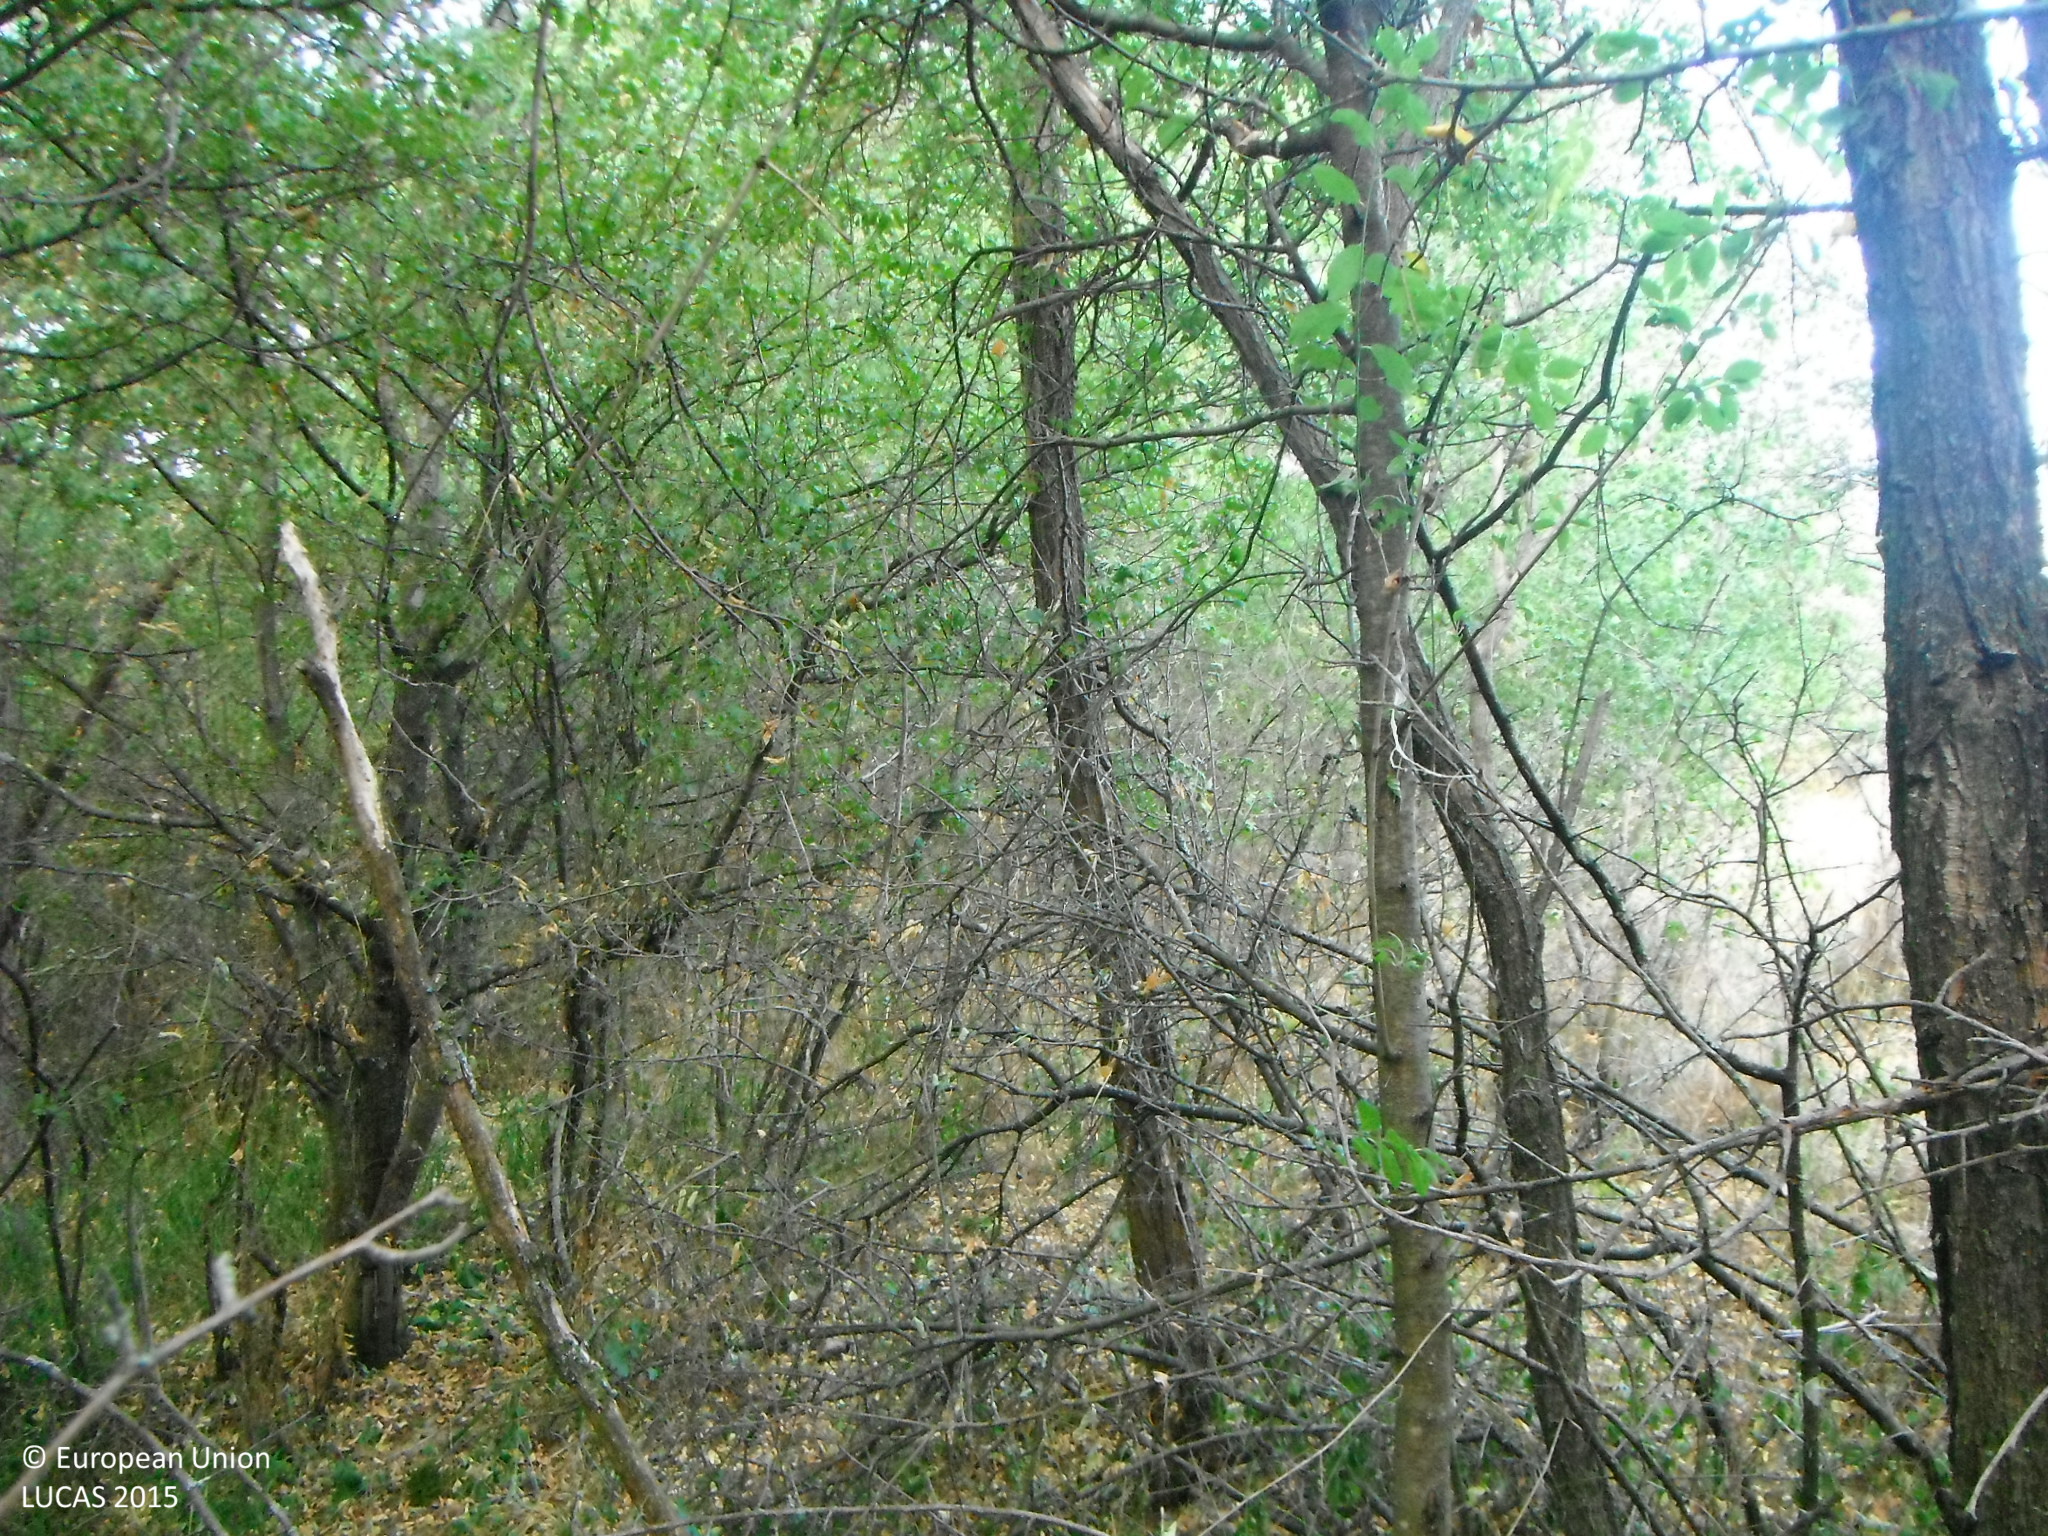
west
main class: Woodland
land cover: Broadleaved woodland
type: mesophytic deciduous forest
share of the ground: > 75 %
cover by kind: broadleaved forest trees 100 %
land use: Semi-natural and natural areas not in use
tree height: > 5 m
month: July
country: SK
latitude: 48.2640
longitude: 19.0869
